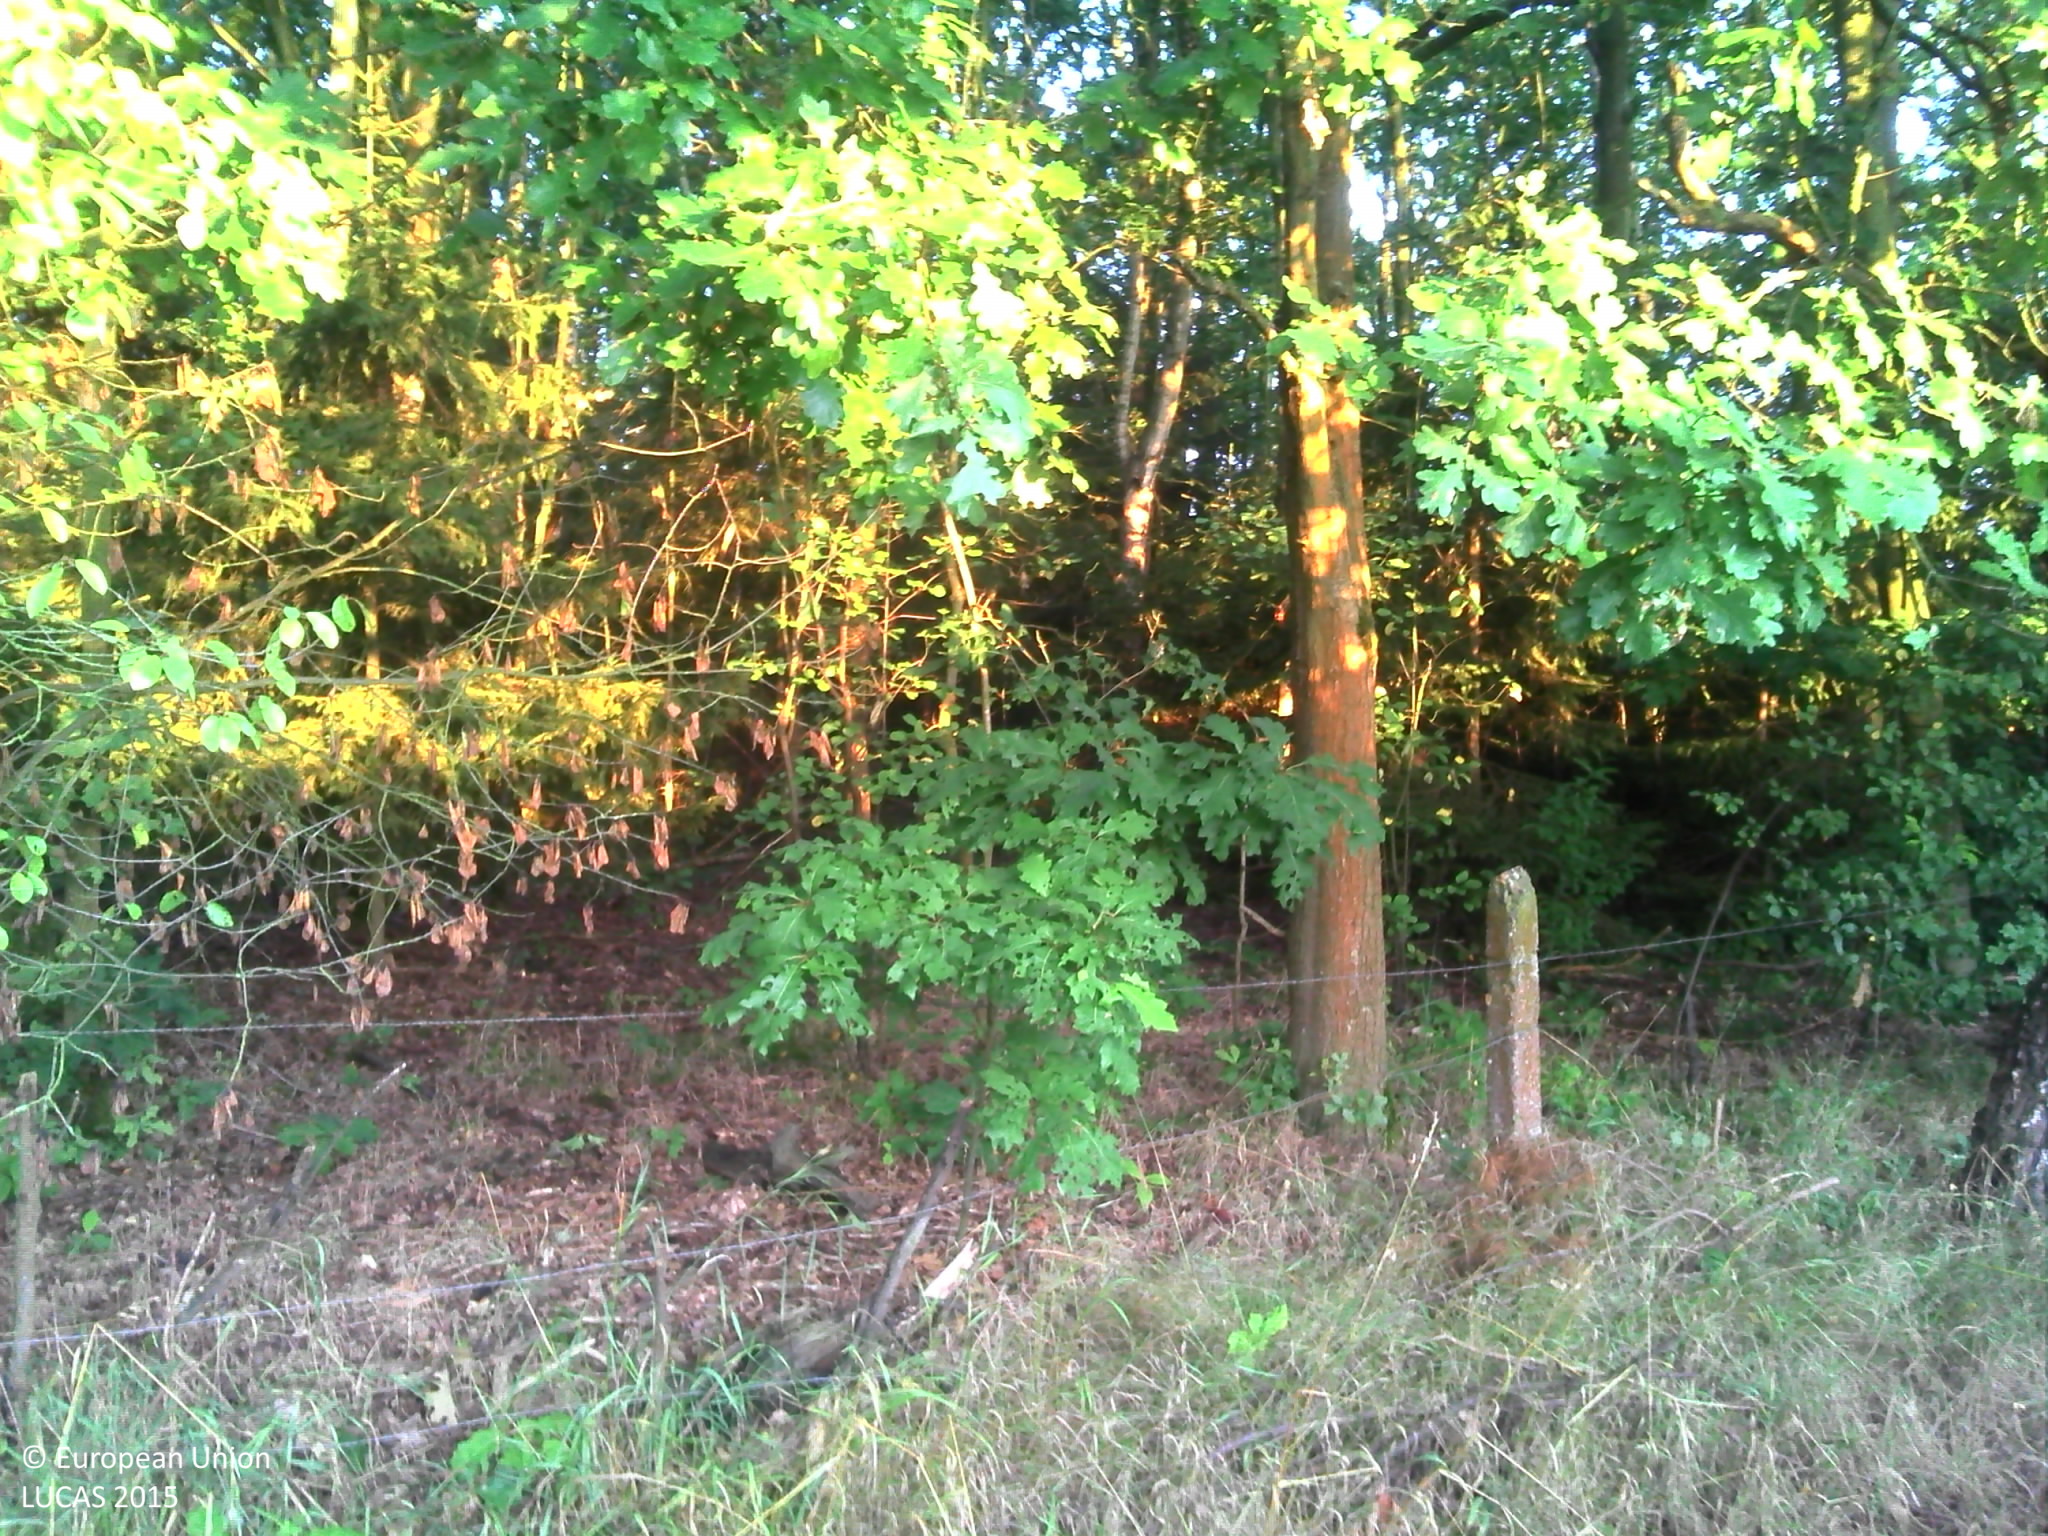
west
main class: Cropland
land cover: Maize
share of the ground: > 75 %
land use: Agriculture (excluding fallow land and kitchen gardens)
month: August
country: BE
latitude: 51.1199
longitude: 5.0111
